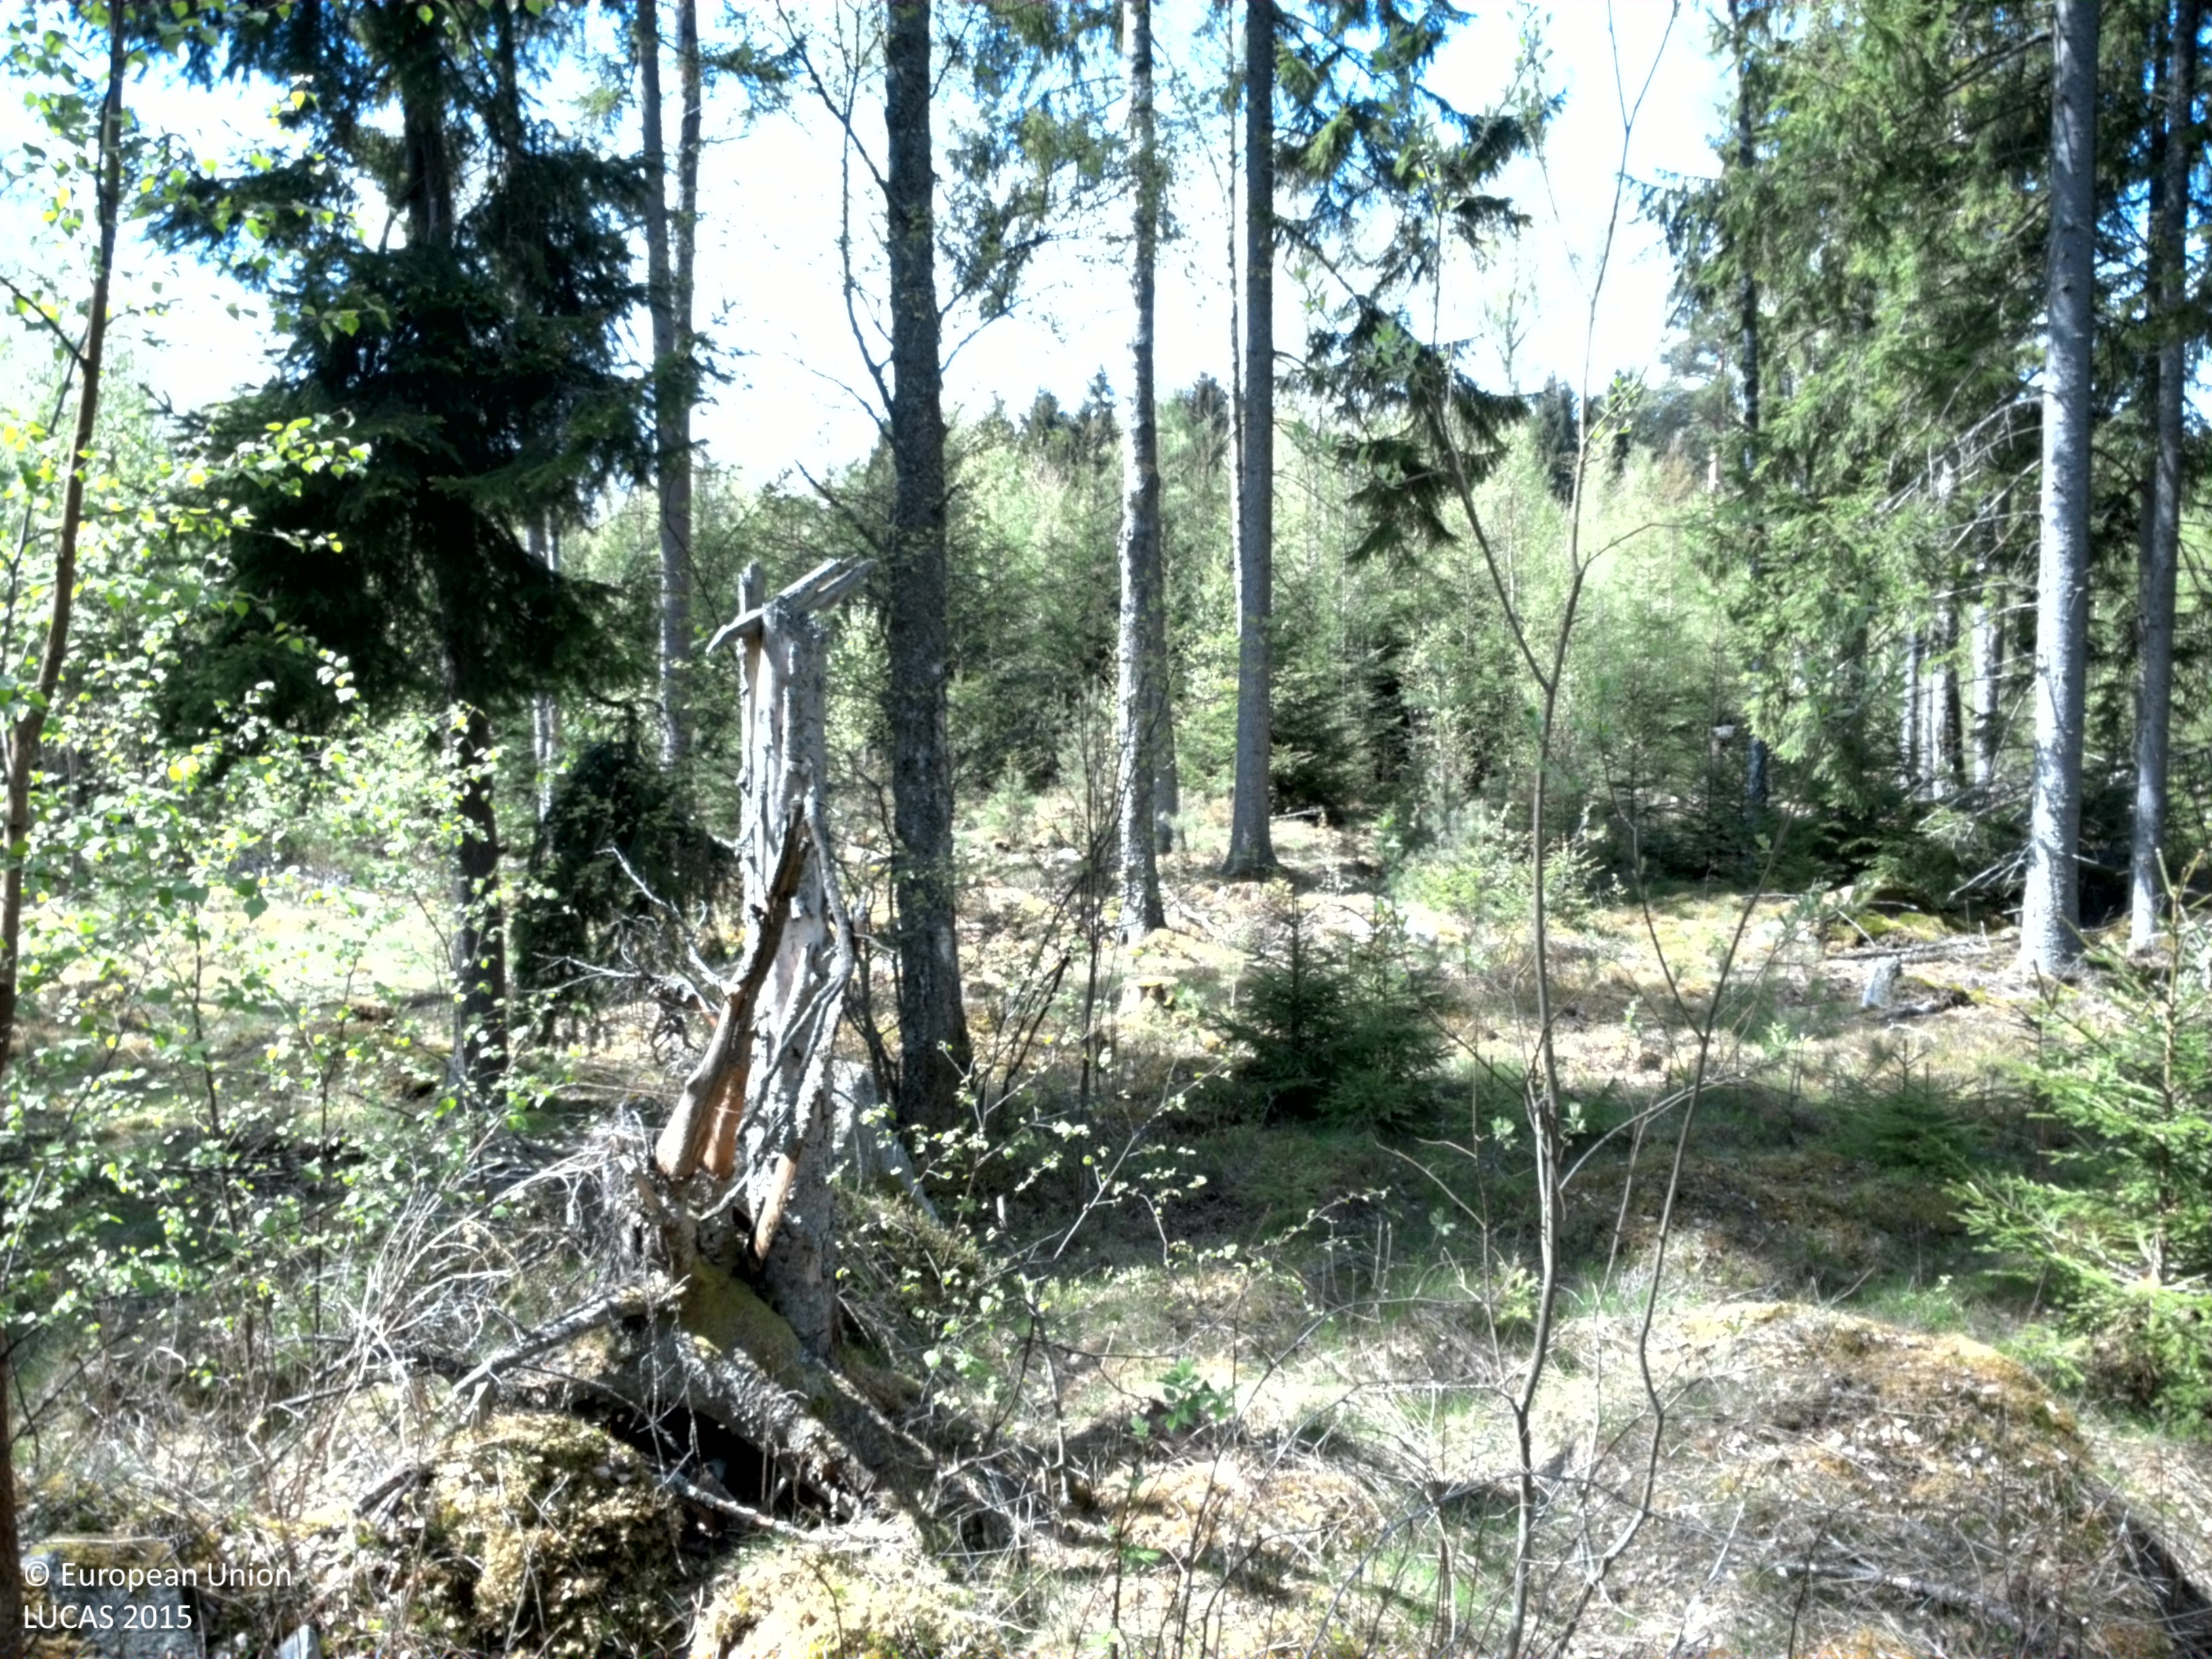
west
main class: Woodland
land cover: Spruce dominated mixed woodland
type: boreal forest
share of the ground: 50 - 75 %
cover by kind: broadleaved forest trees 45 %, coniferous forest trees 25 %, herbaceous plants 15 %, lichens and mosses 15 %
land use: Forestry
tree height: > 5 m
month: May
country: SE
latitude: 56.6728
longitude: 14.8445
